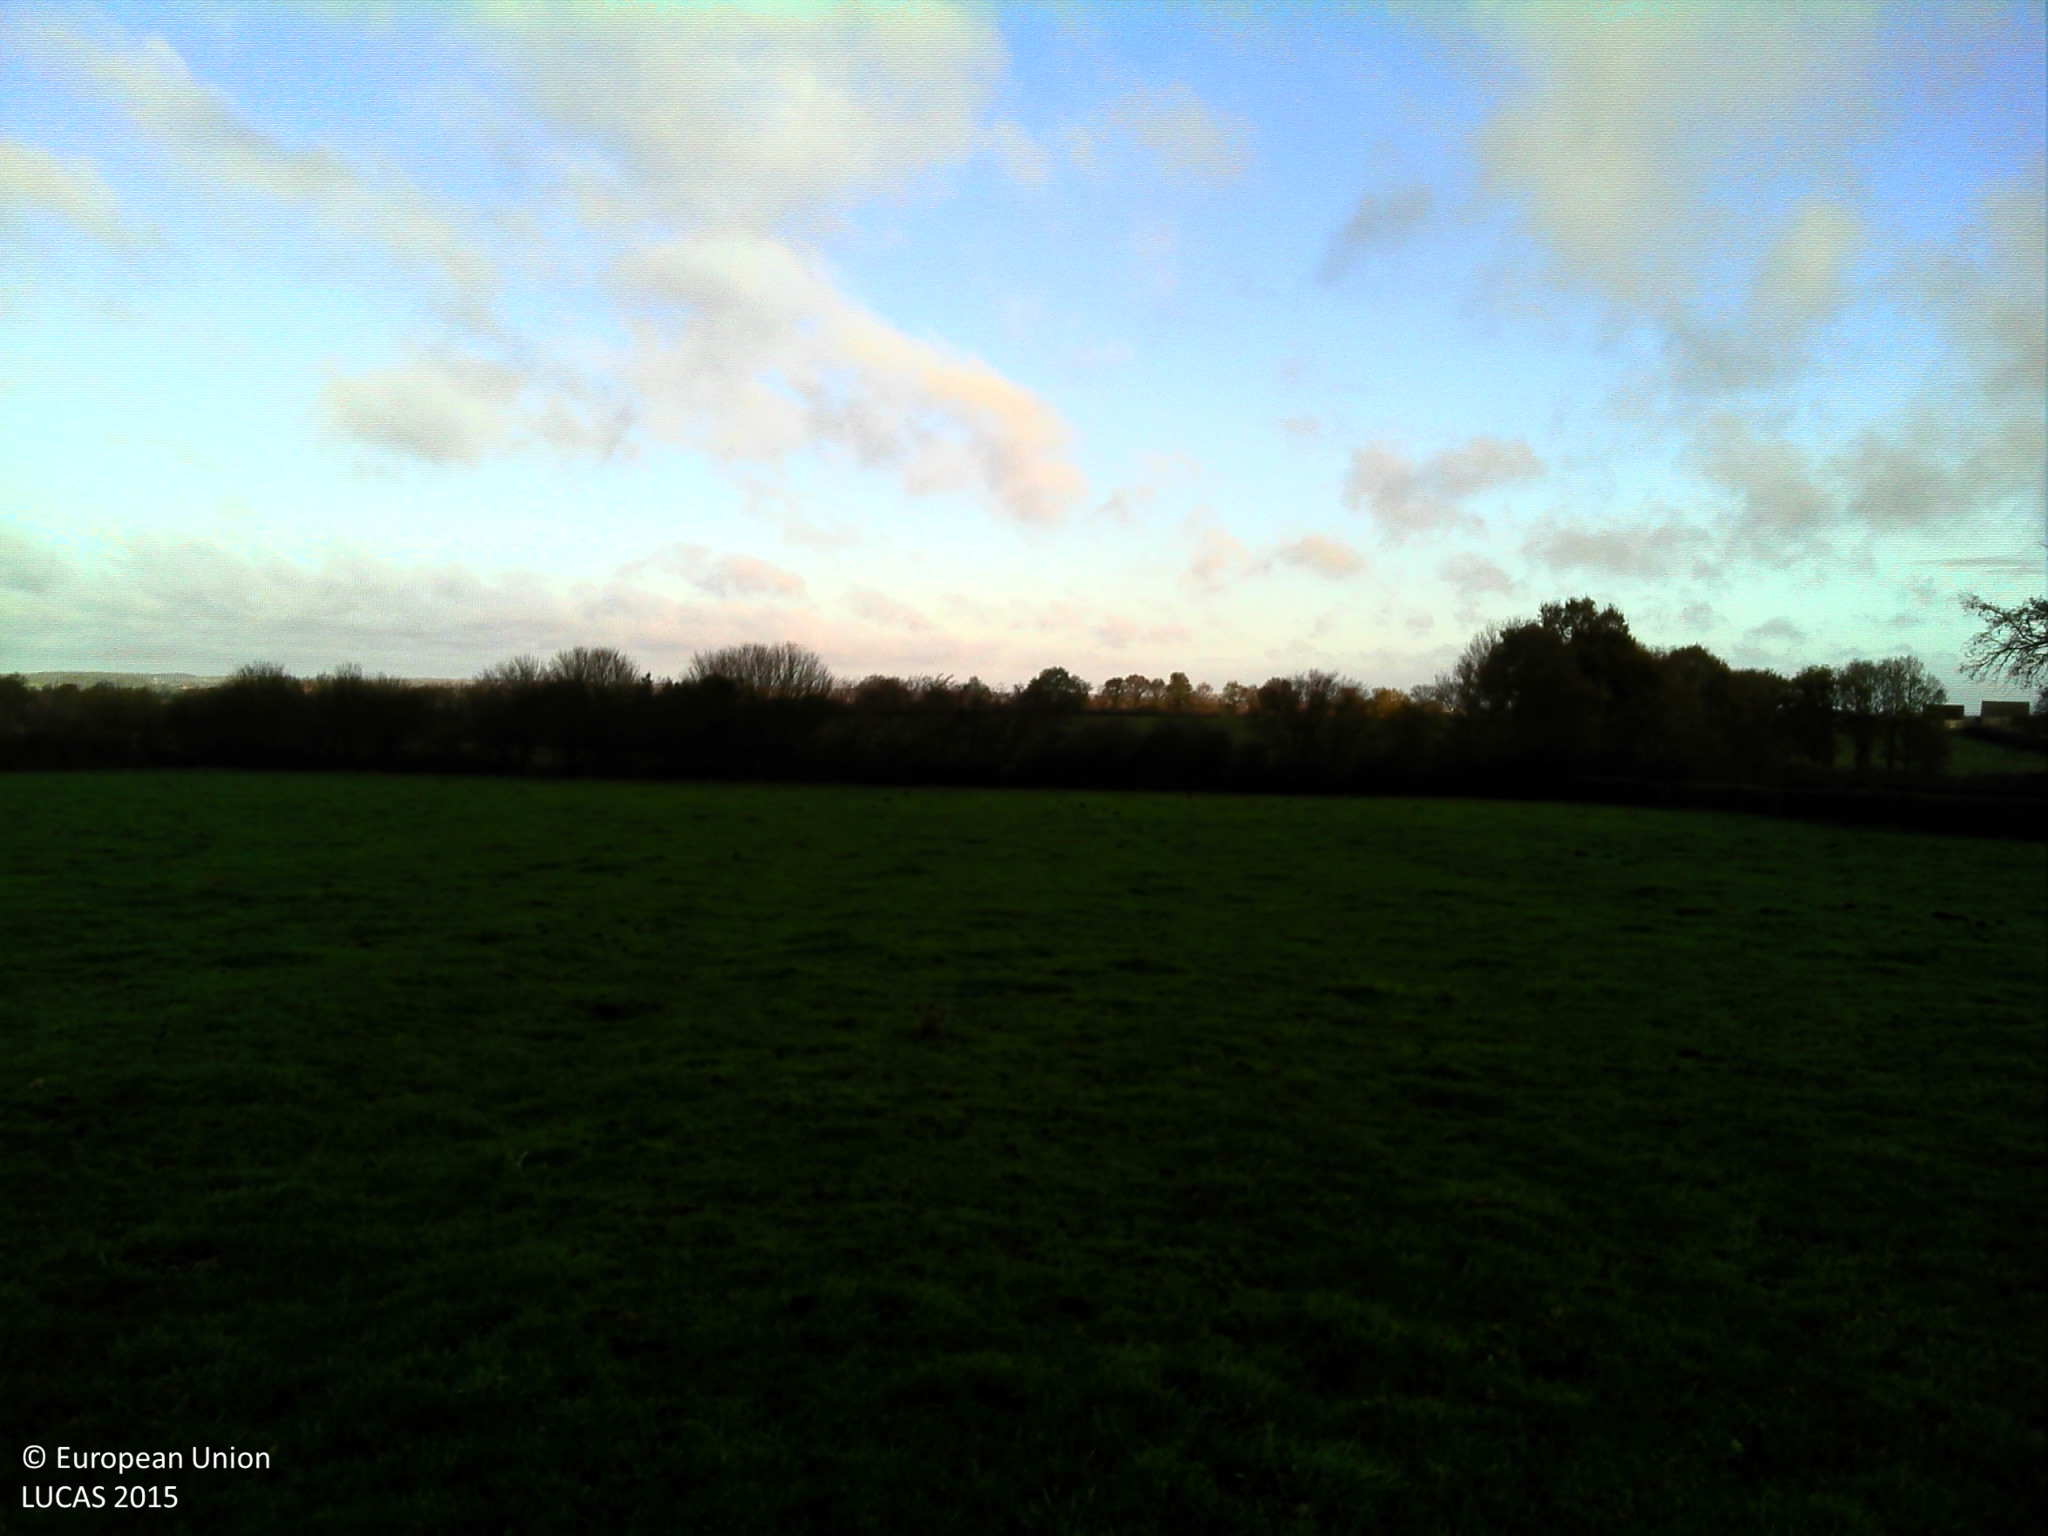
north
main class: Grassland
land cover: Grassland without tree/shrub cover
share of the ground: > 75 %
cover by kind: herbaceous plants 100 %
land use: Agriculture (excluding fallow land and kitchen gardens)
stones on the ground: < 10 %
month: August
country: FR
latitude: 46.4521
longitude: 3.6593
